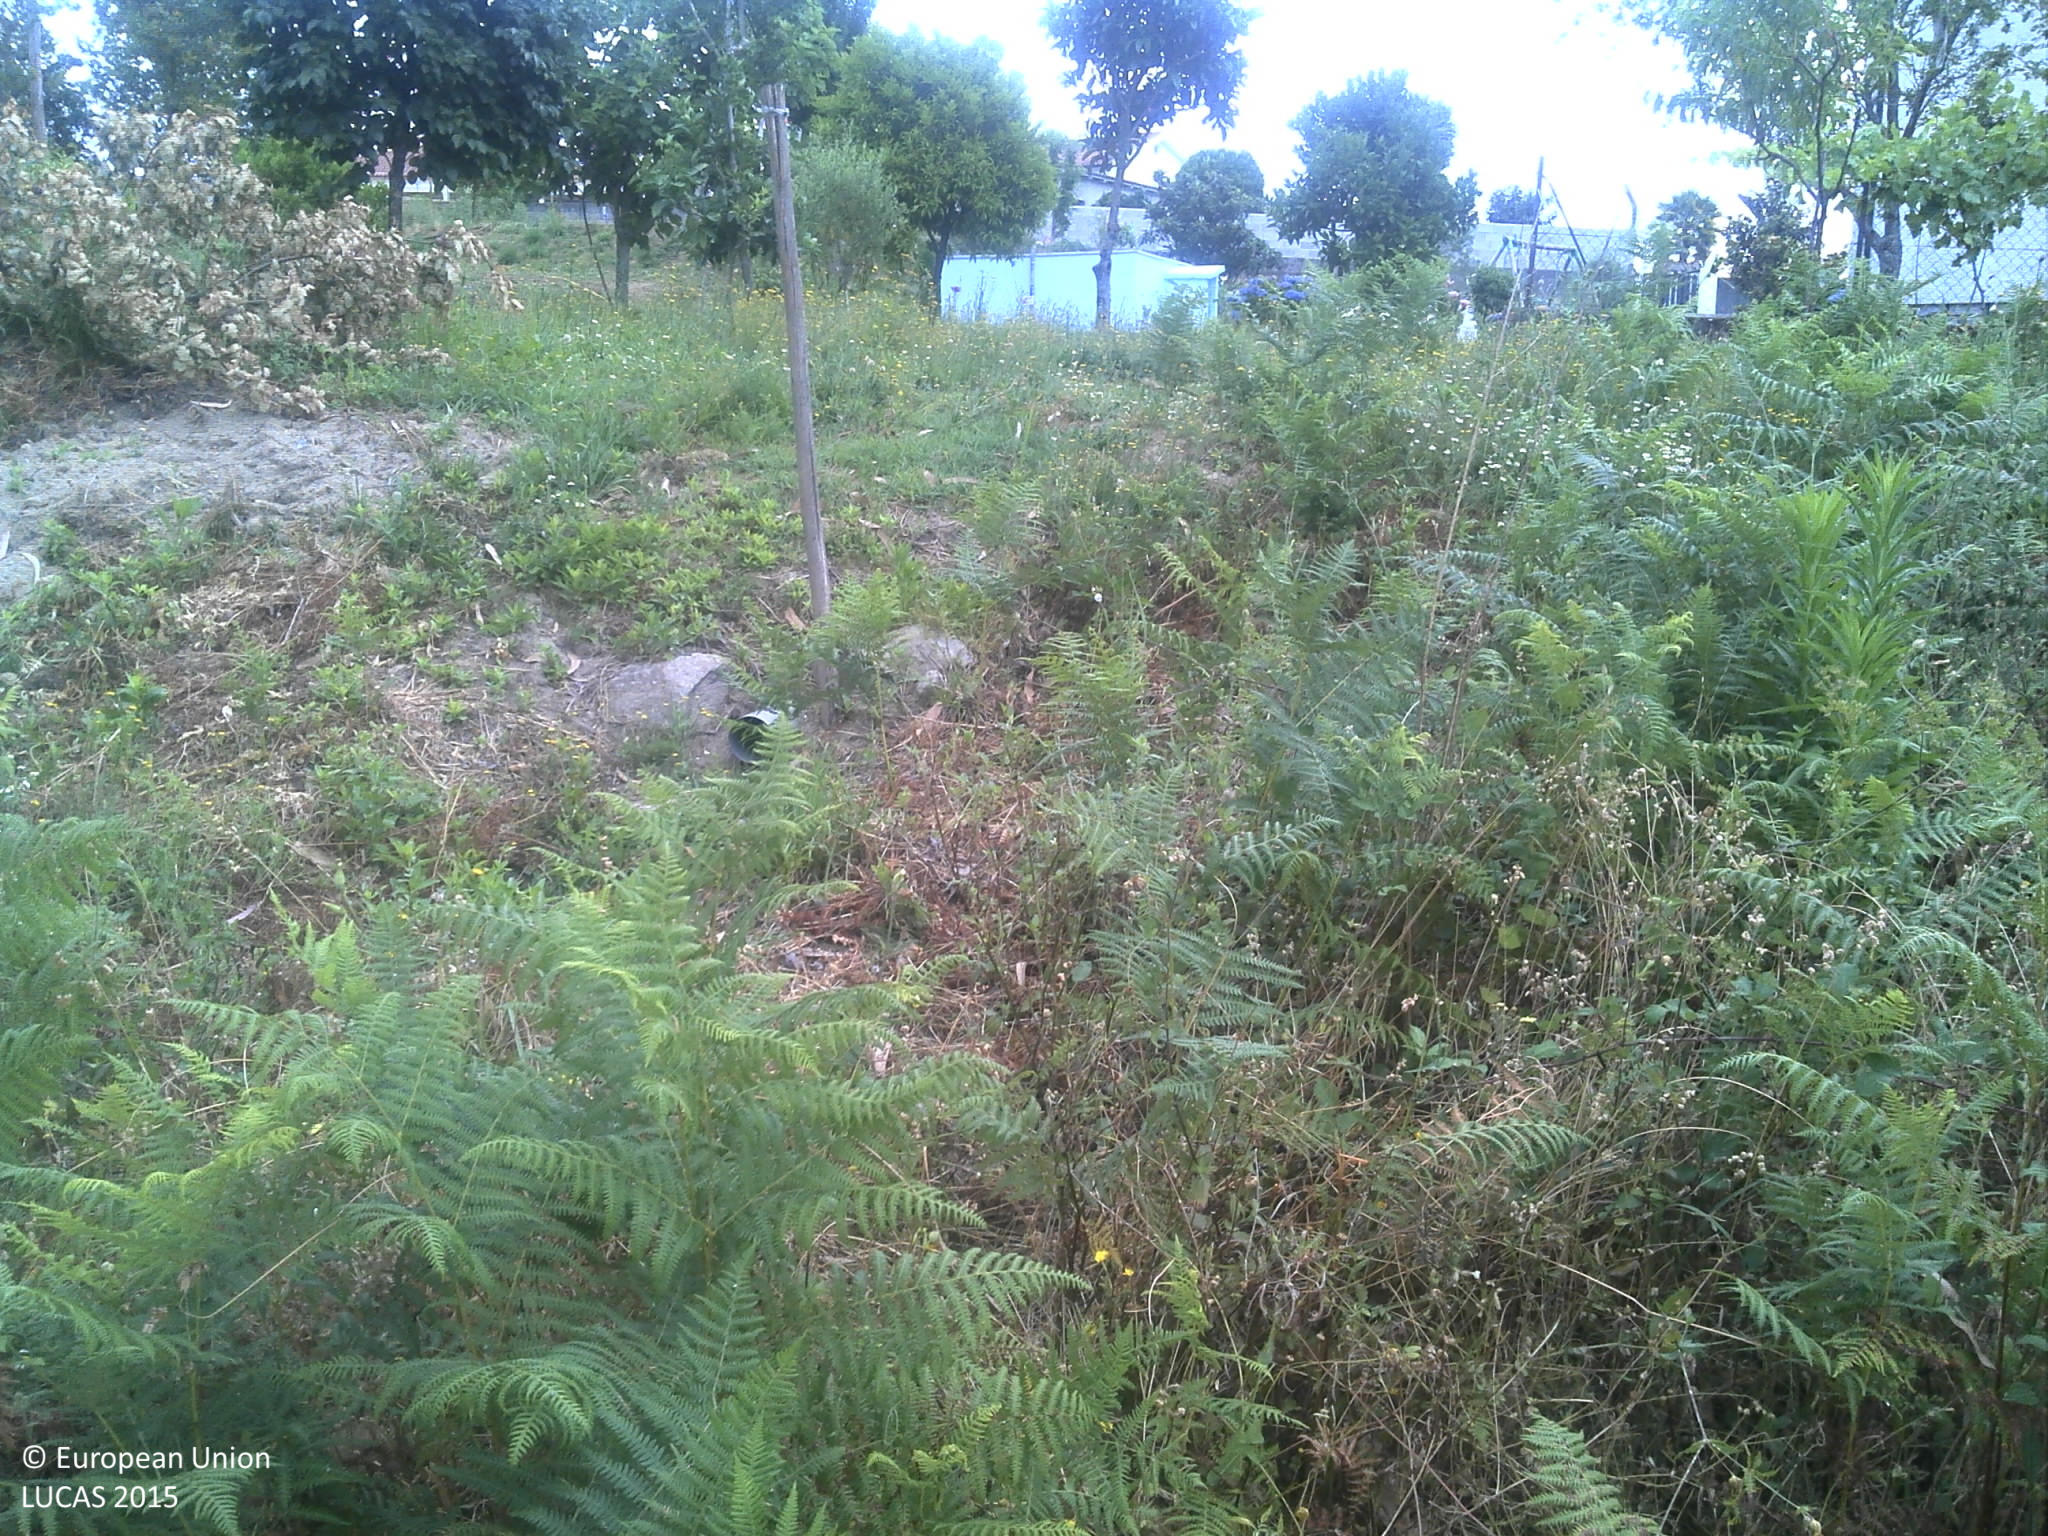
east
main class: Shrubland
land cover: Shrubland with sparse tree cover
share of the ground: 50 - 75 %
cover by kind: shrubs 90 %, broadleaved forest trees 5 %, unconsolidated bare surface 5 %
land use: Forestry
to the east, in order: Shrubland with sparse tree cover; Other fruit trees and berries; Grassland without tree/shrub cover; Artificial constructions in urban areas; Broadleaved woodland; Arable land (only in case pi); Single bushes/trees; Grass margins; Tracks; Grassland without tree/shrub cover
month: June
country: PT
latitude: 41.6367
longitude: -8.3894
